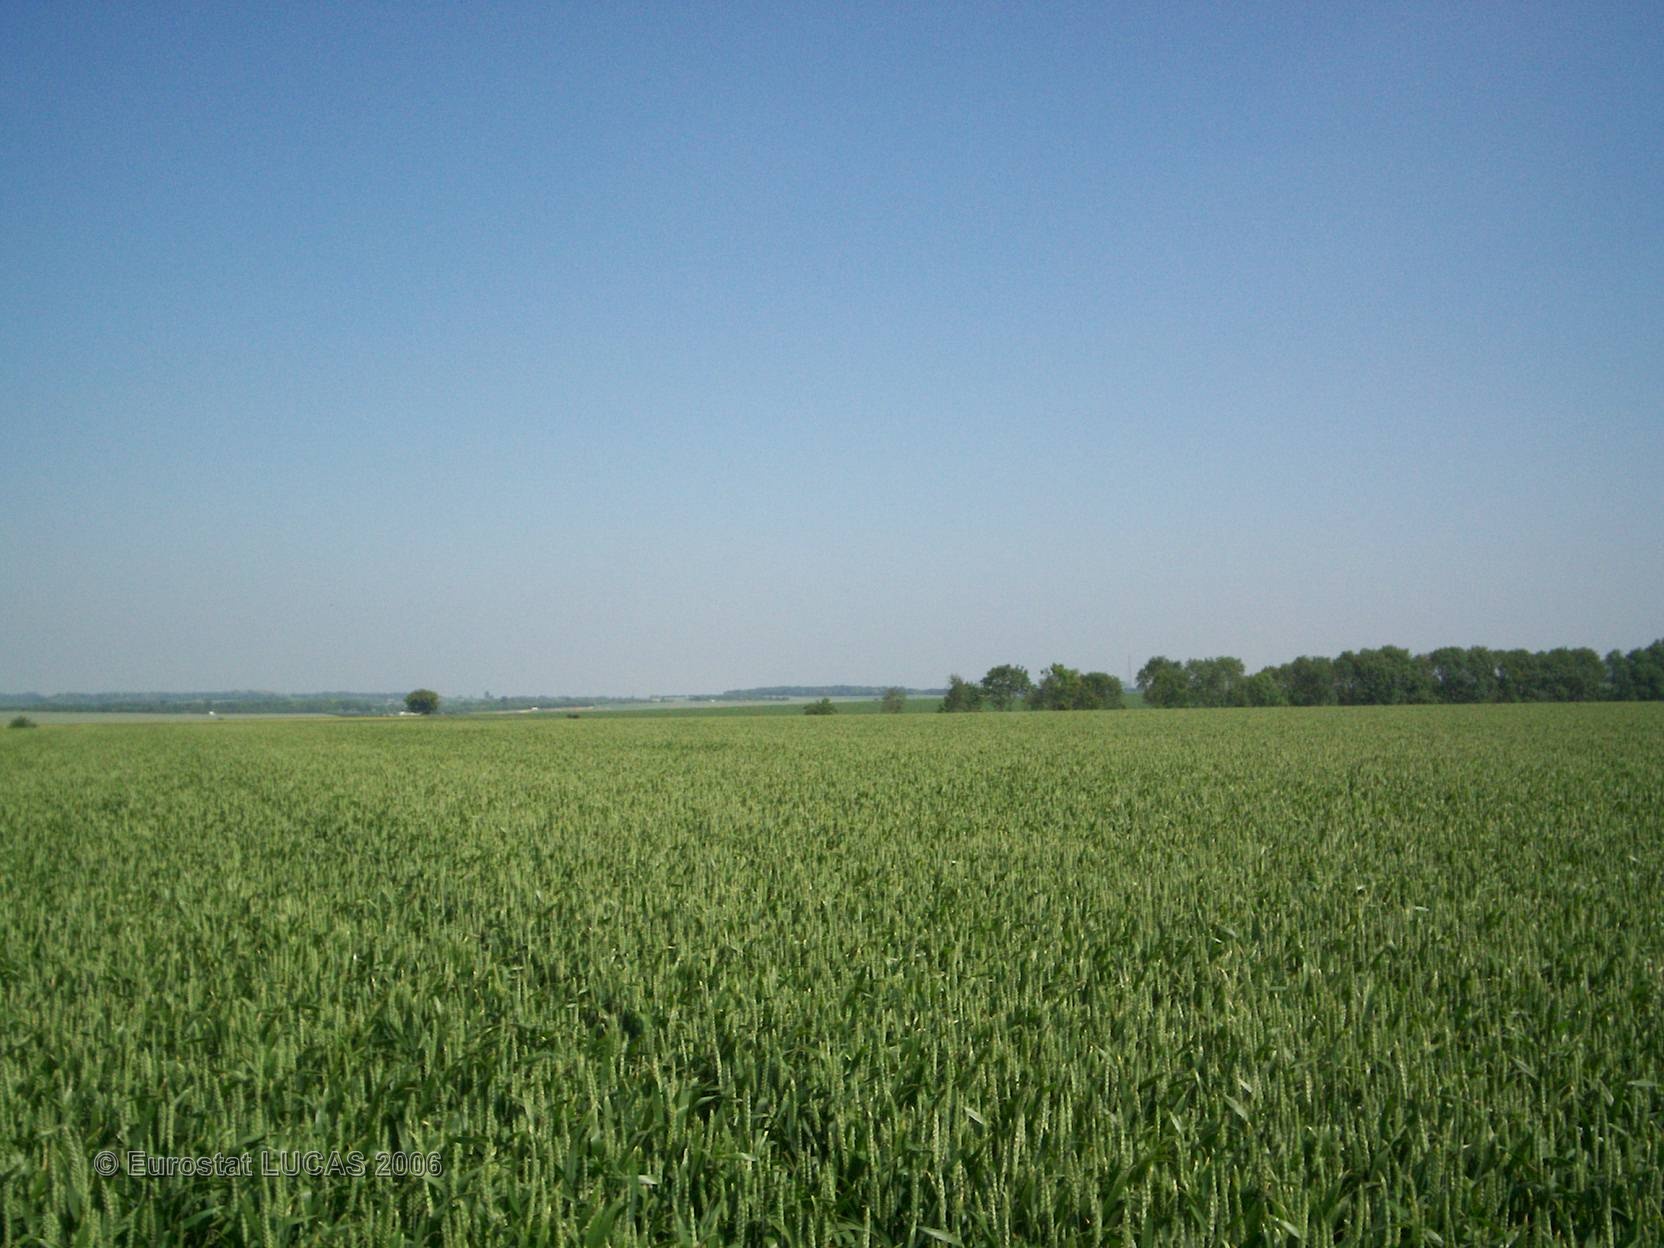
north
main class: Cropland
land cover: Common wheat
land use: Agriculture (excluding fallow land and kitchen gardens)
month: June
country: FR
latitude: 49.4995
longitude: 2.7124
